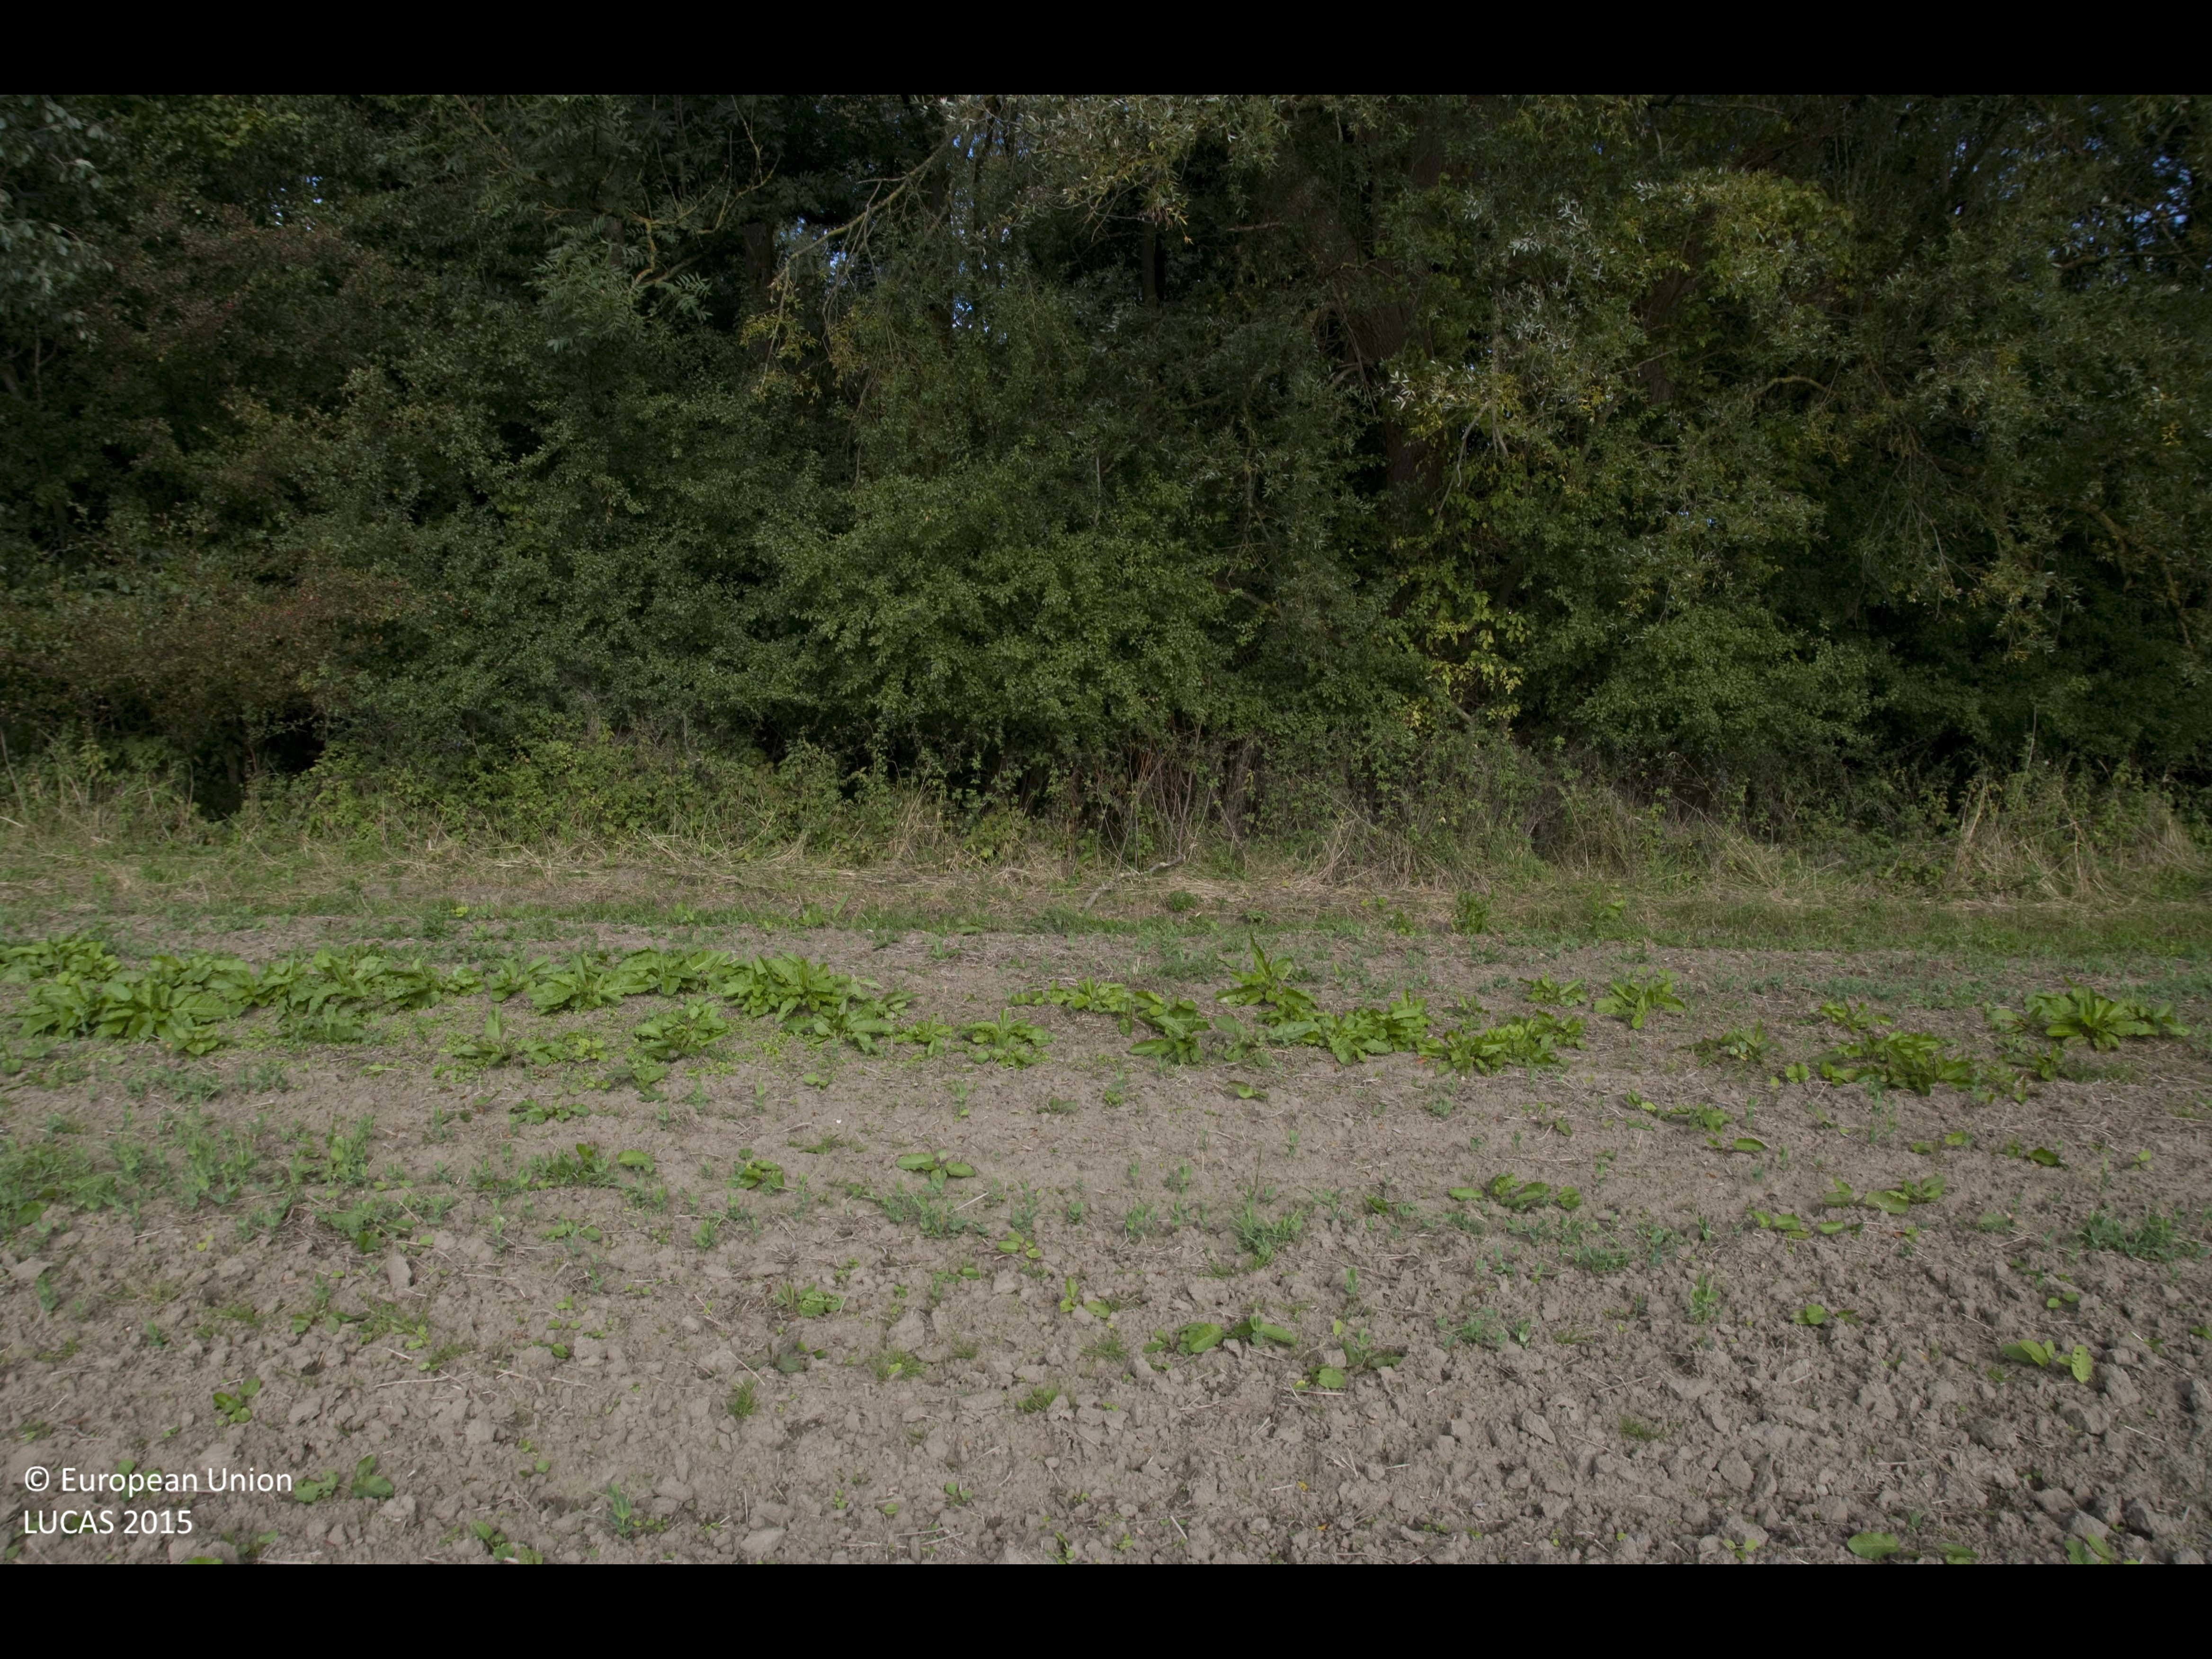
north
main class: Cropland
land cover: Dry pulses
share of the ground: < 10 %
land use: Agriculture (excluding fallow land and kitchen gardens)
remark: Harvested field
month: September
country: DE
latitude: 53.9730
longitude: 10.9904
